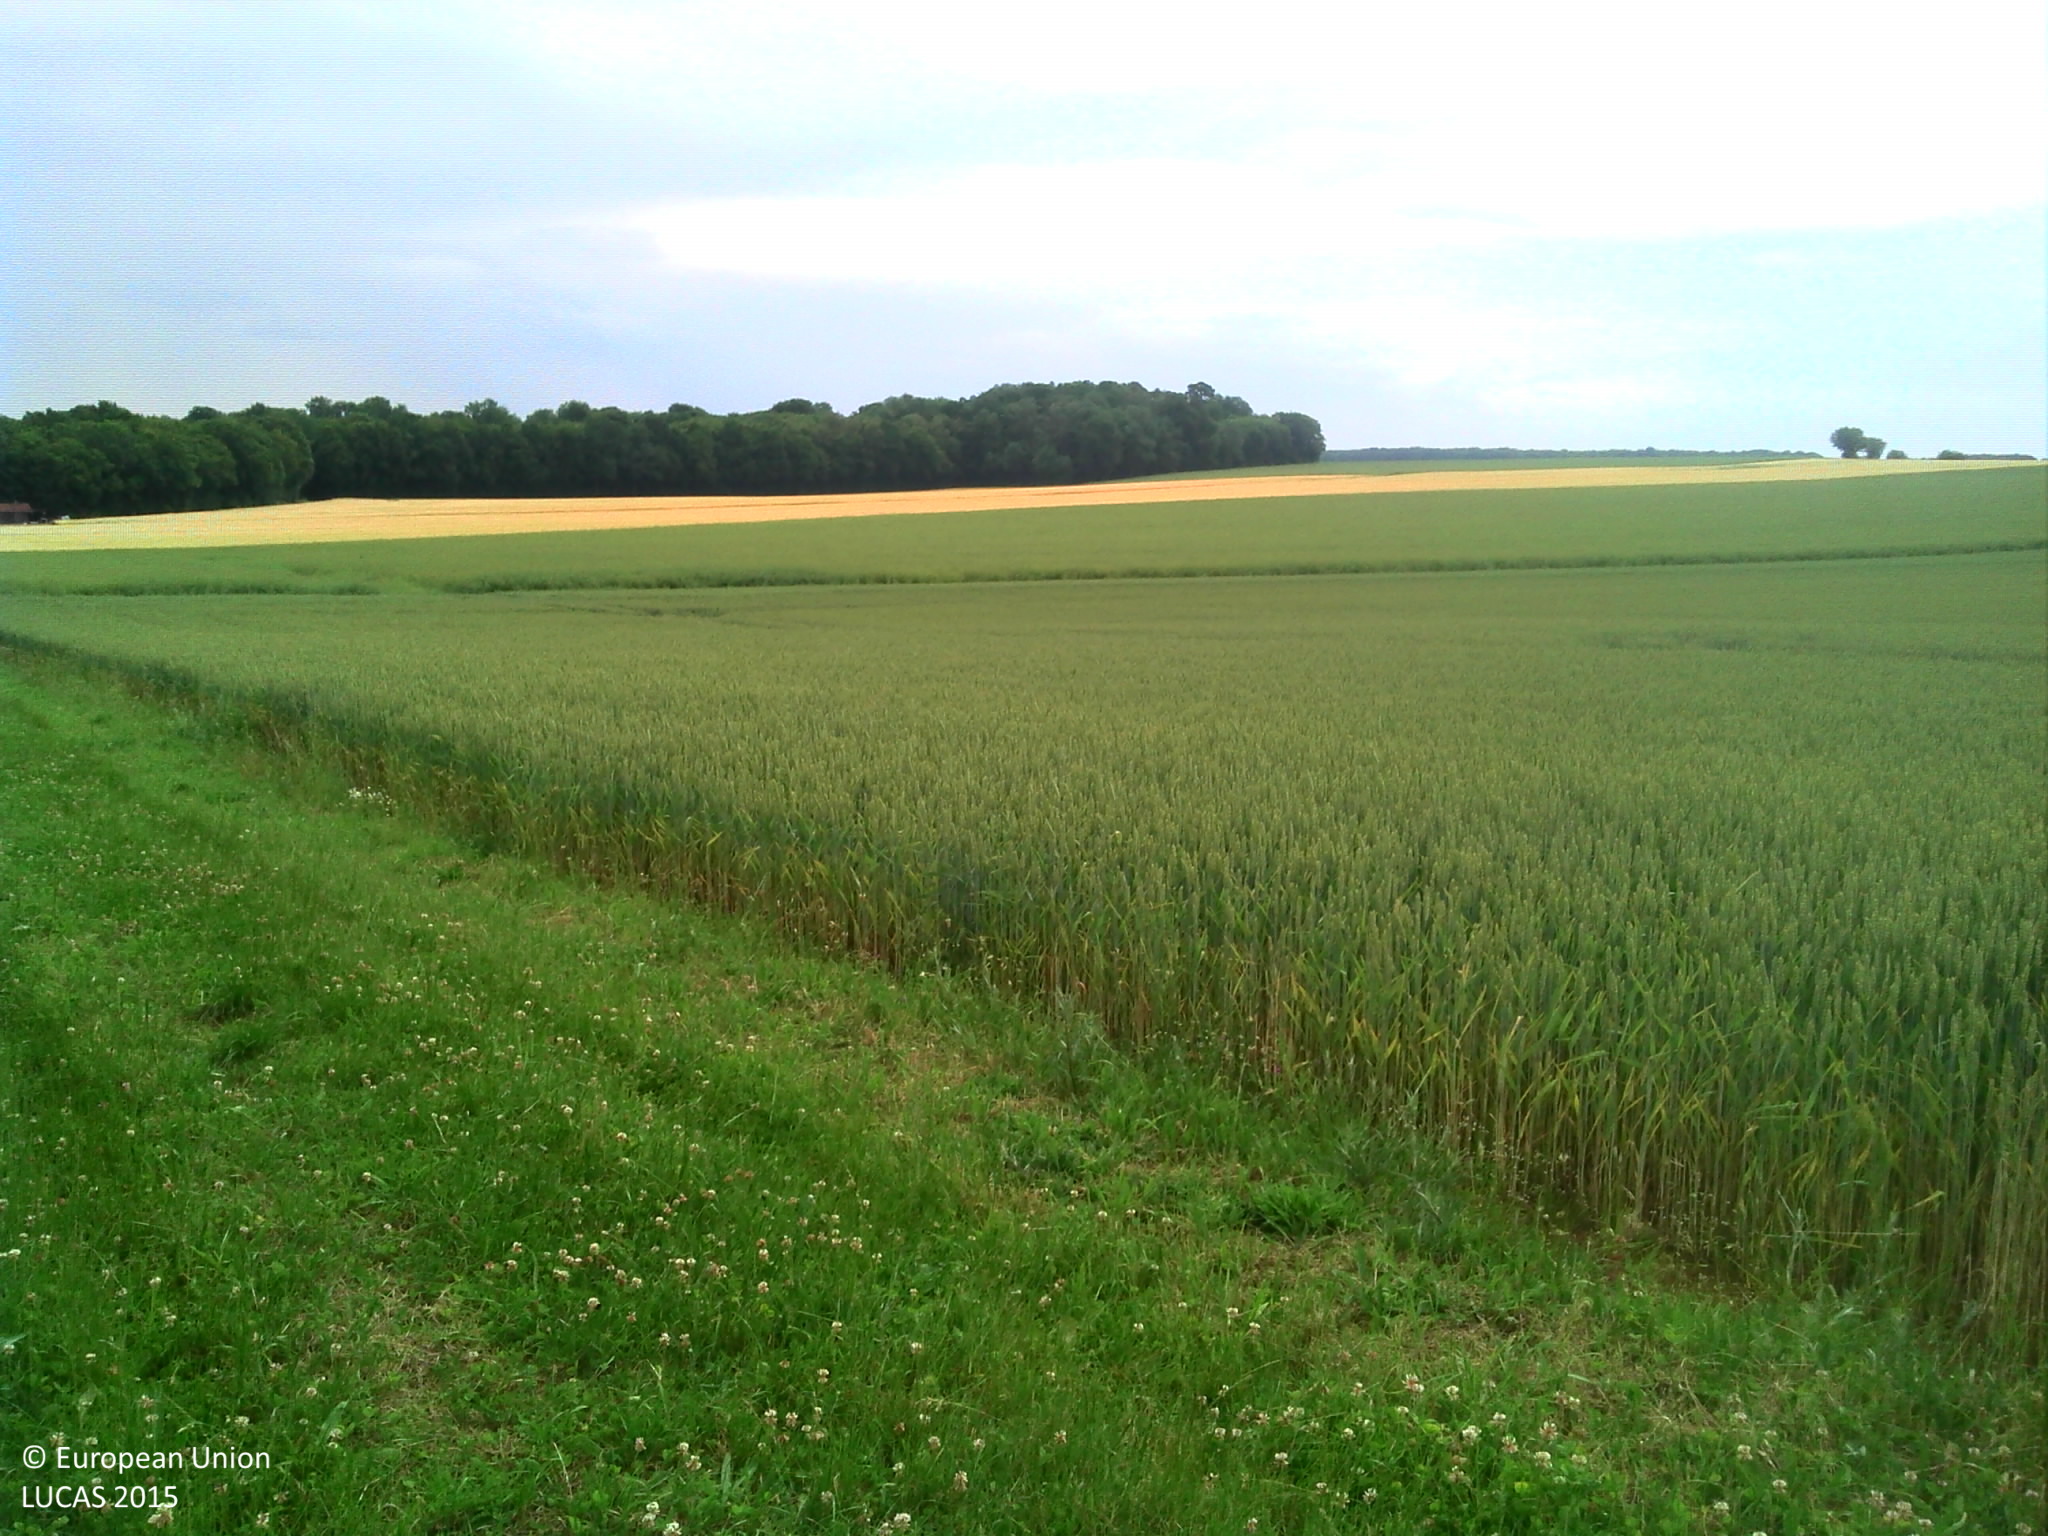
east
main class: Cropland
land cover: Rape and turnip rape
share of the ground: > 75 %
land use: Agriculture (excluding fallow land and kitchen gardens)
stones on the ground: 10 - 25 %
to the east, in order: Rape and turnip rape; Tracks; Common wheat; Rape and turnip rape; Barley
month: June
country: FR
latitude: 48.3788
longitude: 4.9624
